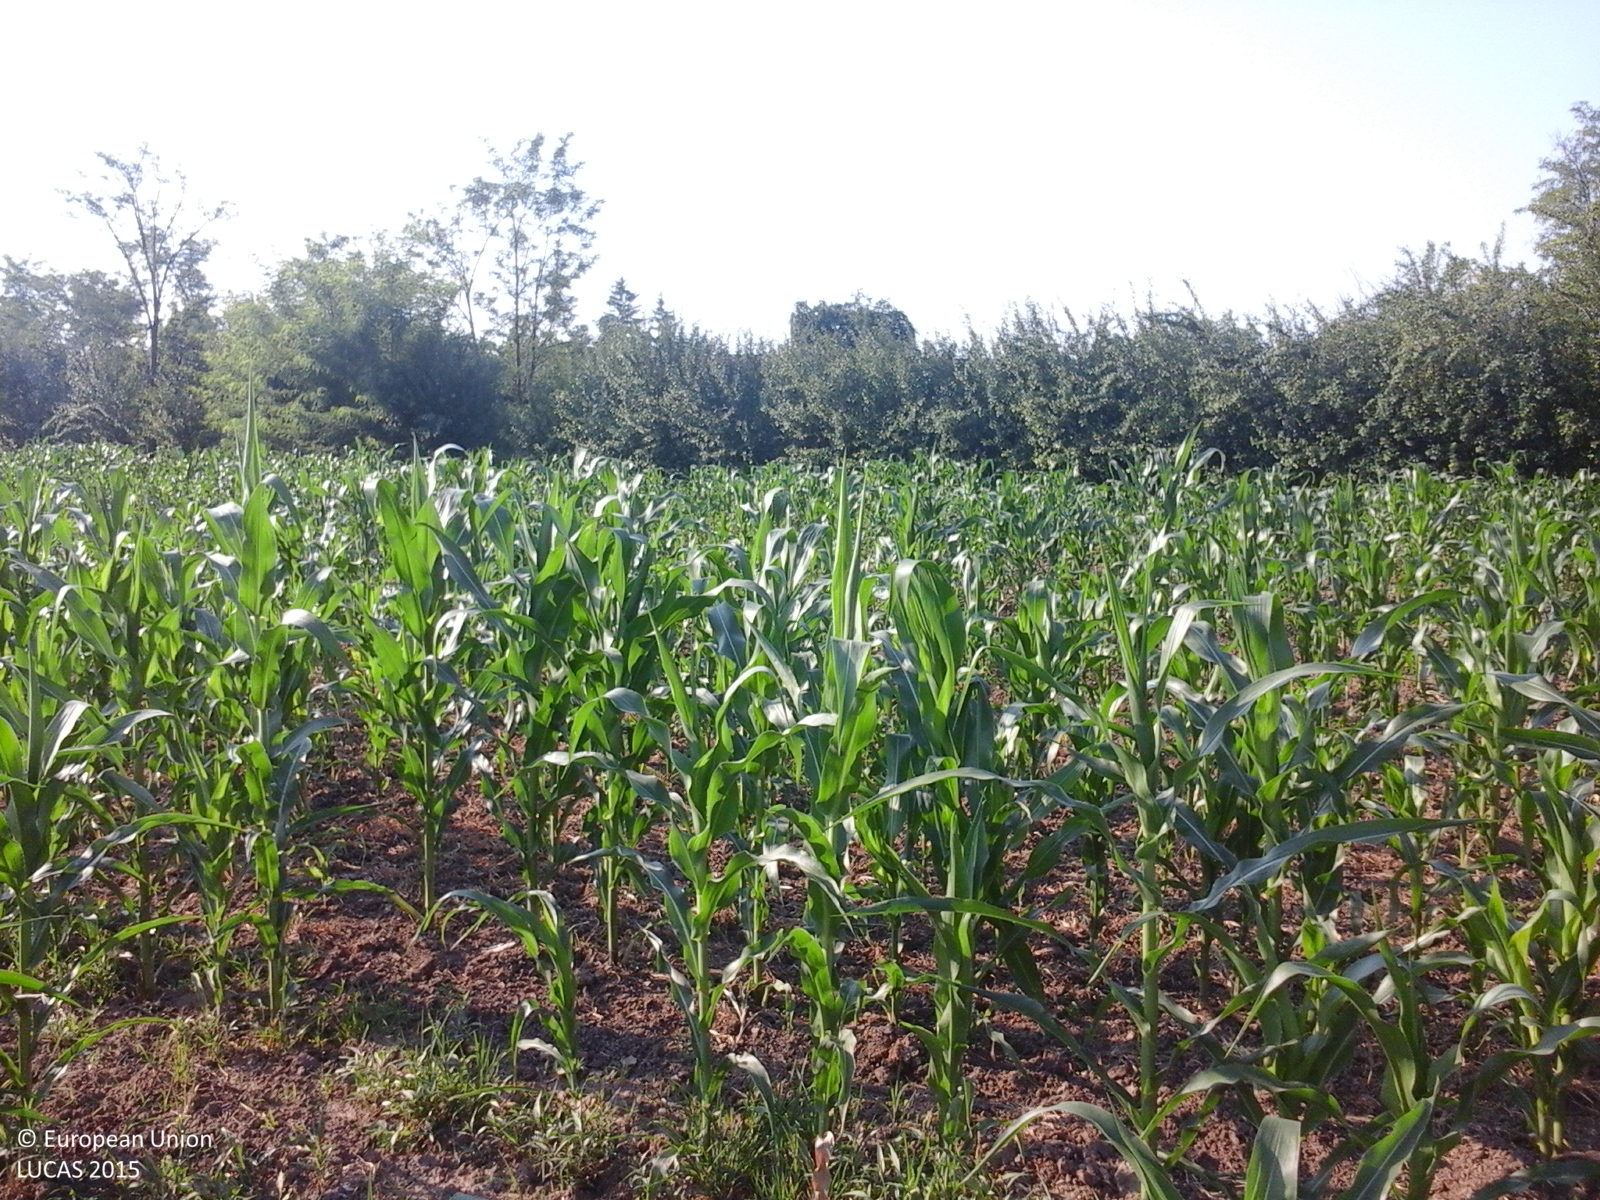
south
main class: Cropland
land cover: Maize
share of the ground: > 75 %
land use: Agriculture (excluding fallow land and kitchen gardens)
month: July
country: RO
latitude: 44.6070
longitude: 24.7561
